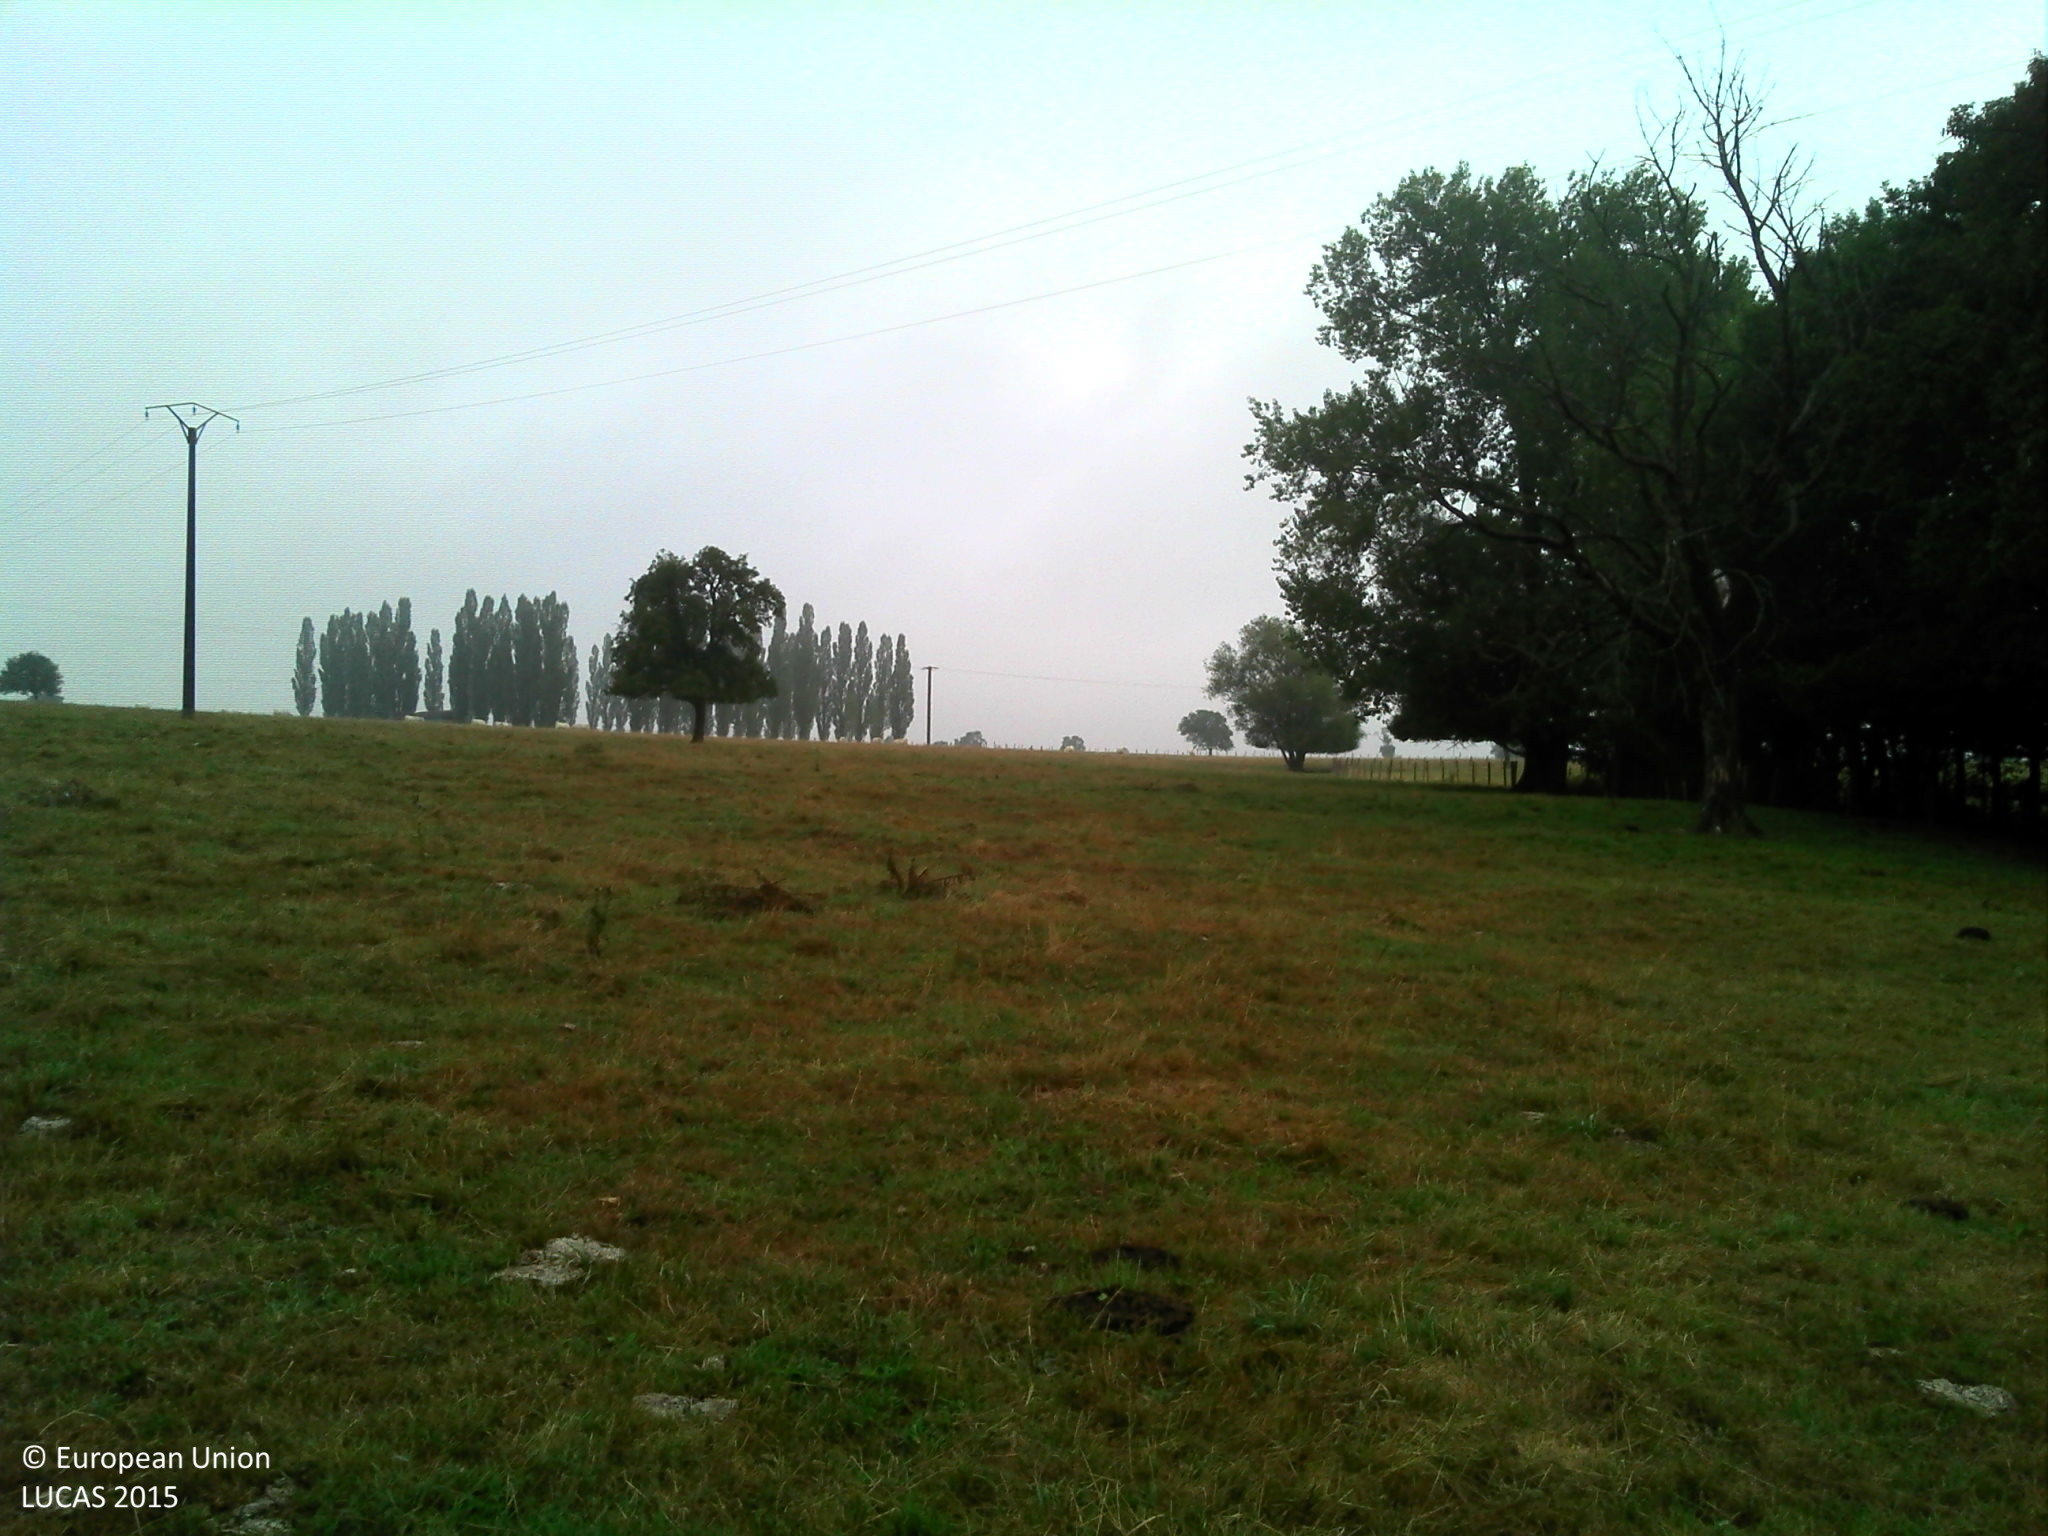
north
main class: Grassland
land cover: Grassland without tree/shrub cover
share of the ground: > 75 %
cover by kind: herbaceous plants 100 %
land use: Agriculture (excluding fallow land and kitchen gardens)
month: August
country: FR
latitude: 48.8377
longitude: 7.2621
